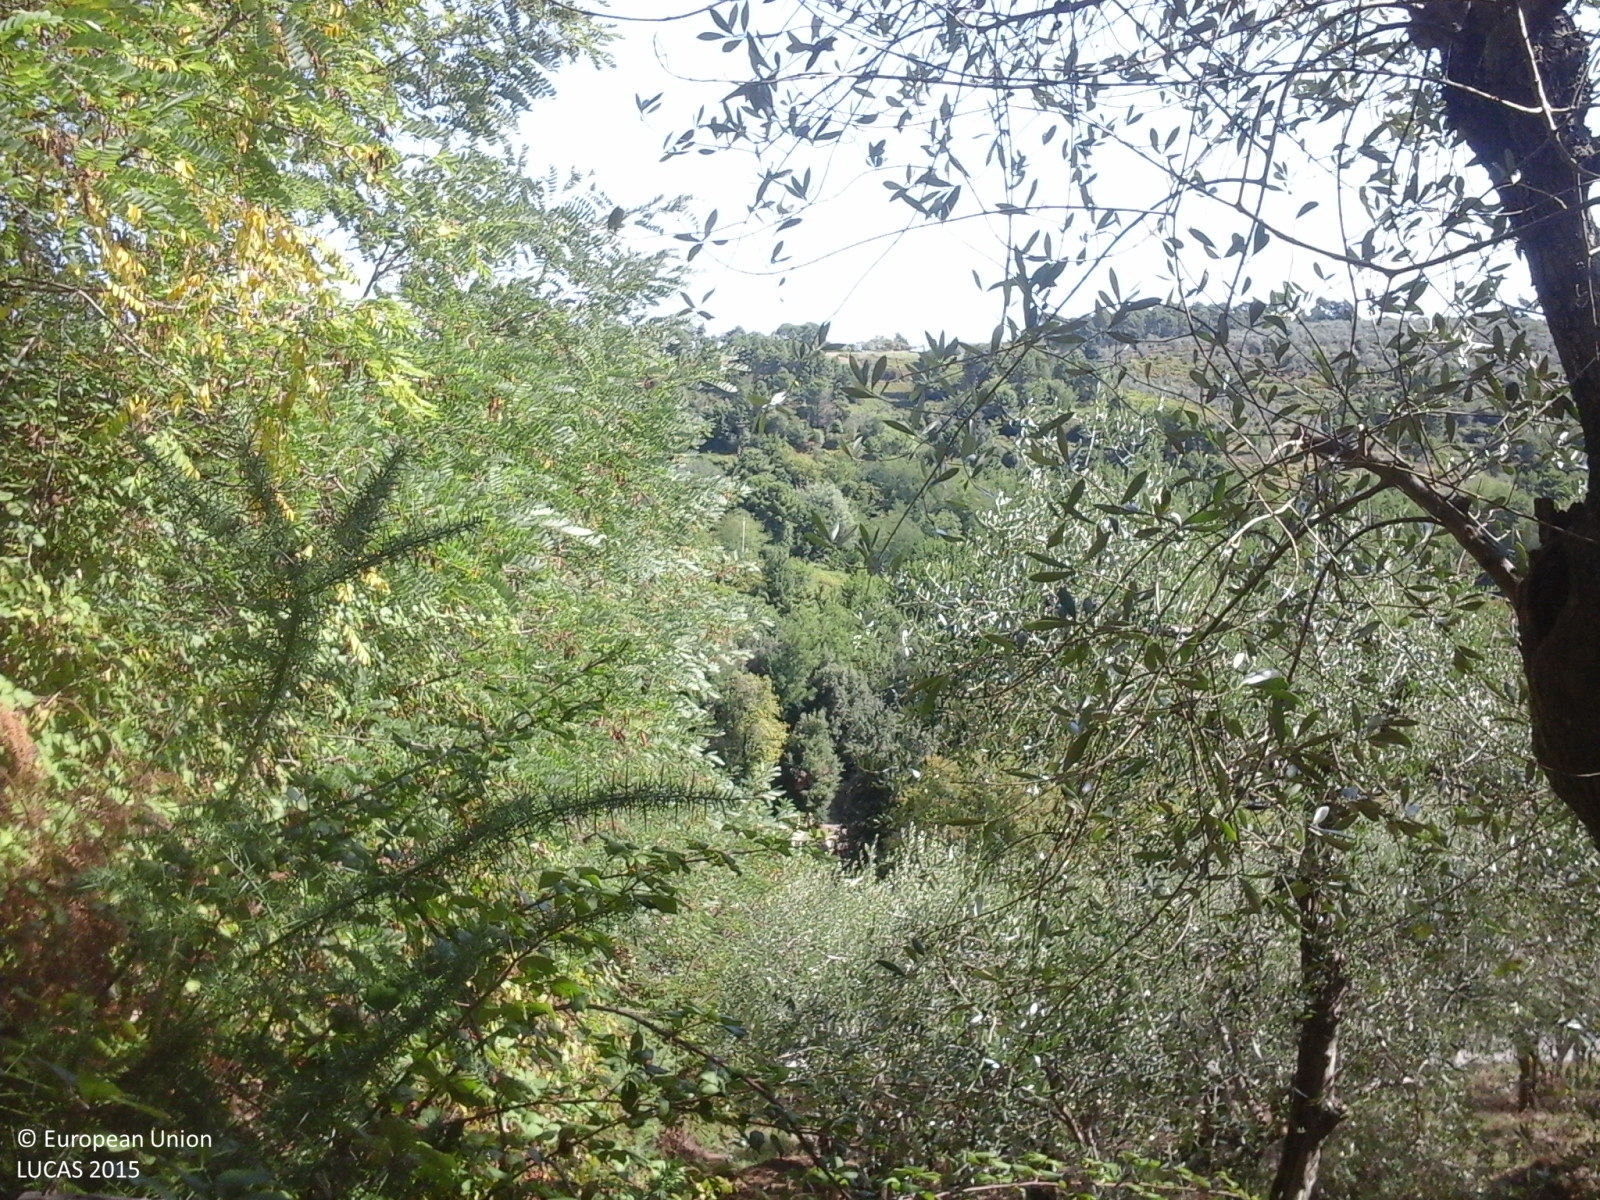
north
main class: Cropland
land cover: Olive groves
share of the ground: > 75 %
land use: Agriculture (excluding fallow land and kitchen gardens)
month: August
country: IT
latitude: 43.7354
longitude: 10.6067
